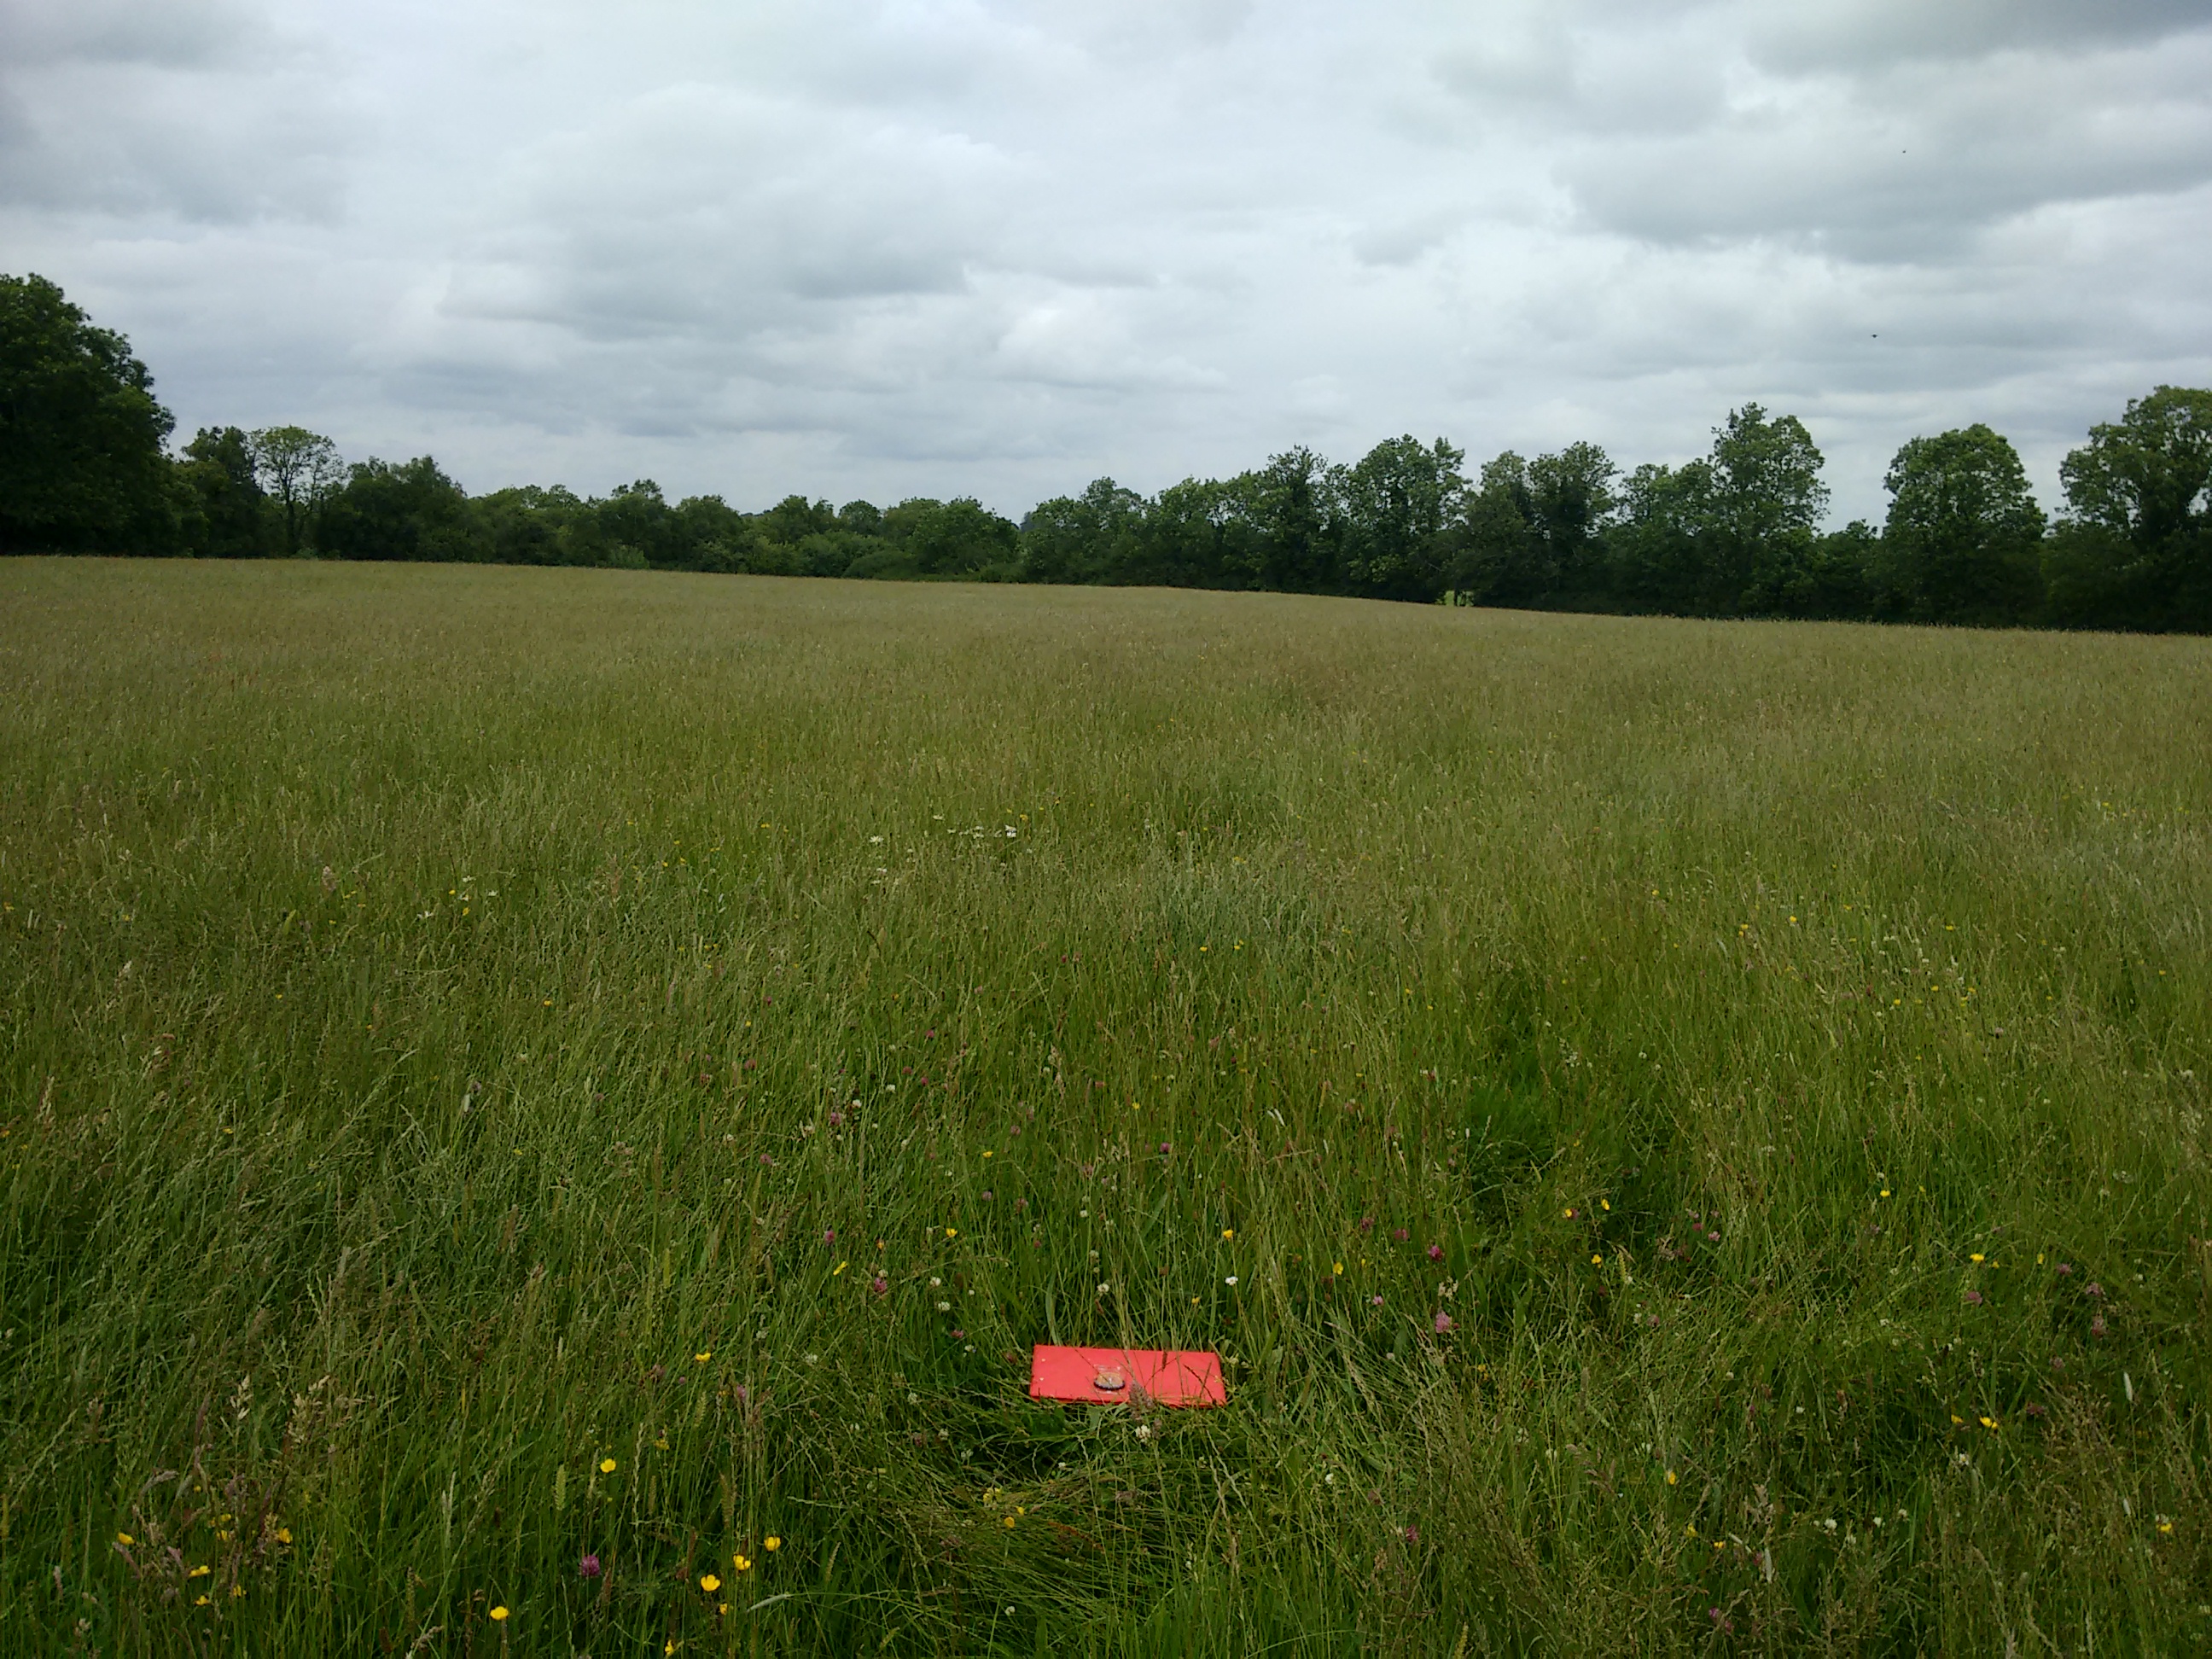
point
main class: Grassland
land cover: Spontaneously vegetated surfaces
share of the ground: > 75 %
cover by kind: herbaceous plants 95 %, shrubs 5 %
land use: Fallow land
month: June
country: IE
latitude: 53.4331
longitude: -7.6690
